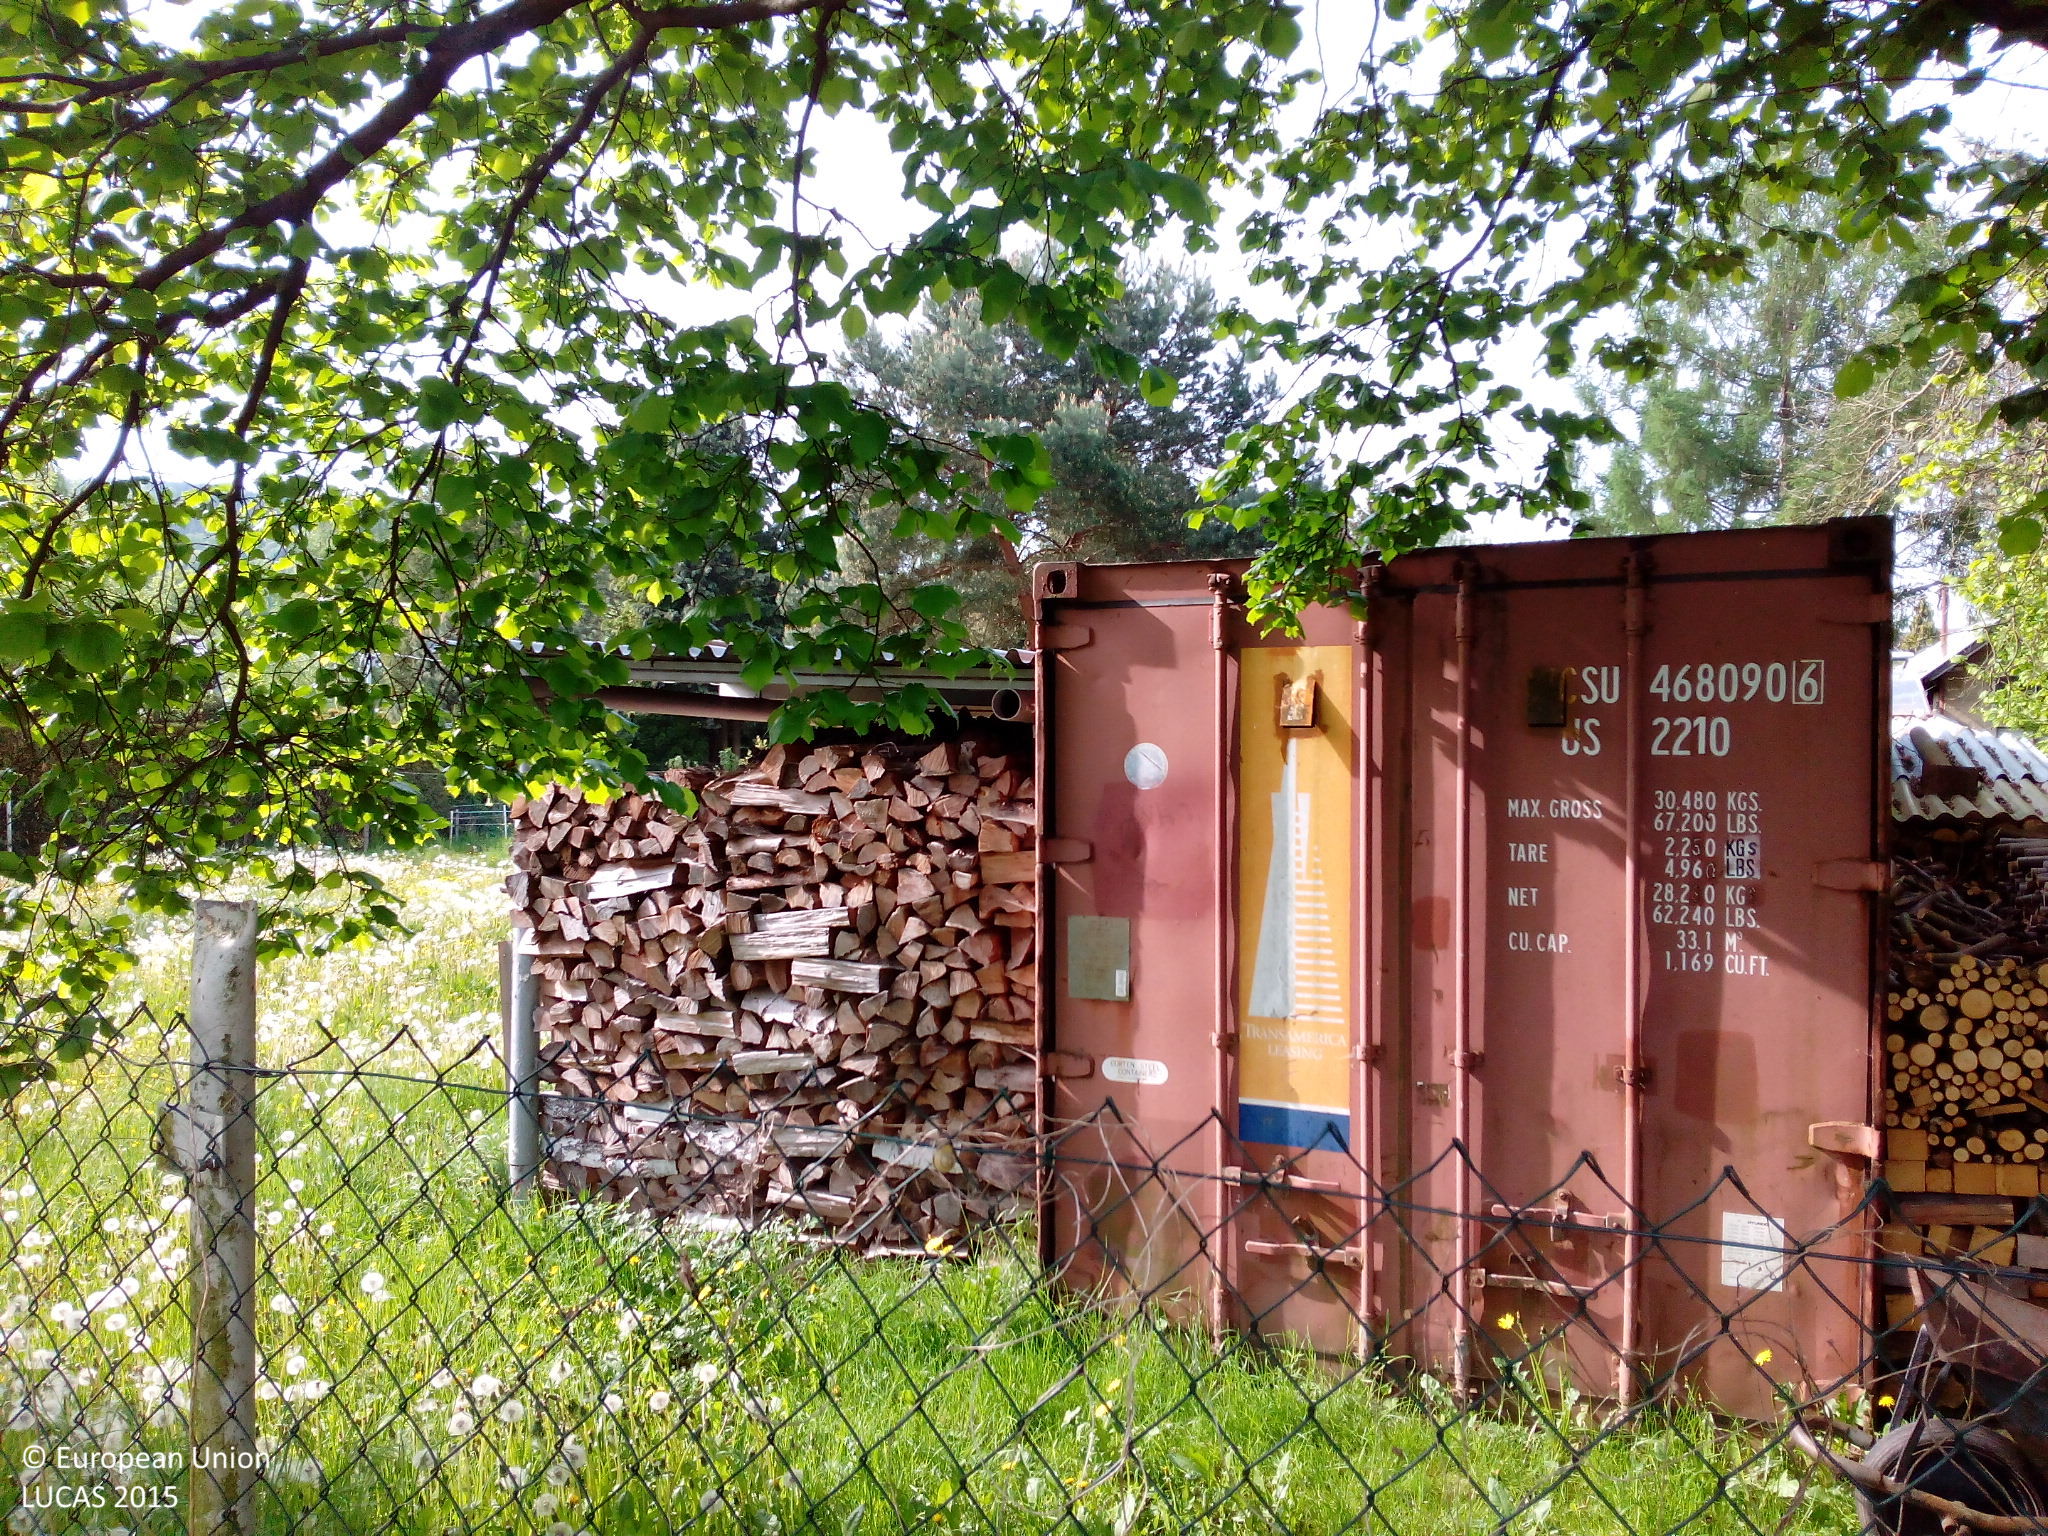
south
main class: Woodland
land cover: Broadleaved woodland
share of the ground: 10 - 25 %
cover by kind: consolidated bare surface 55 %, herbaceous plants 25 %, broadleaved forest trees 20 %
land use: Residential
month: May
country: DE
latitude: 50.8444
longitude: 13.0819
